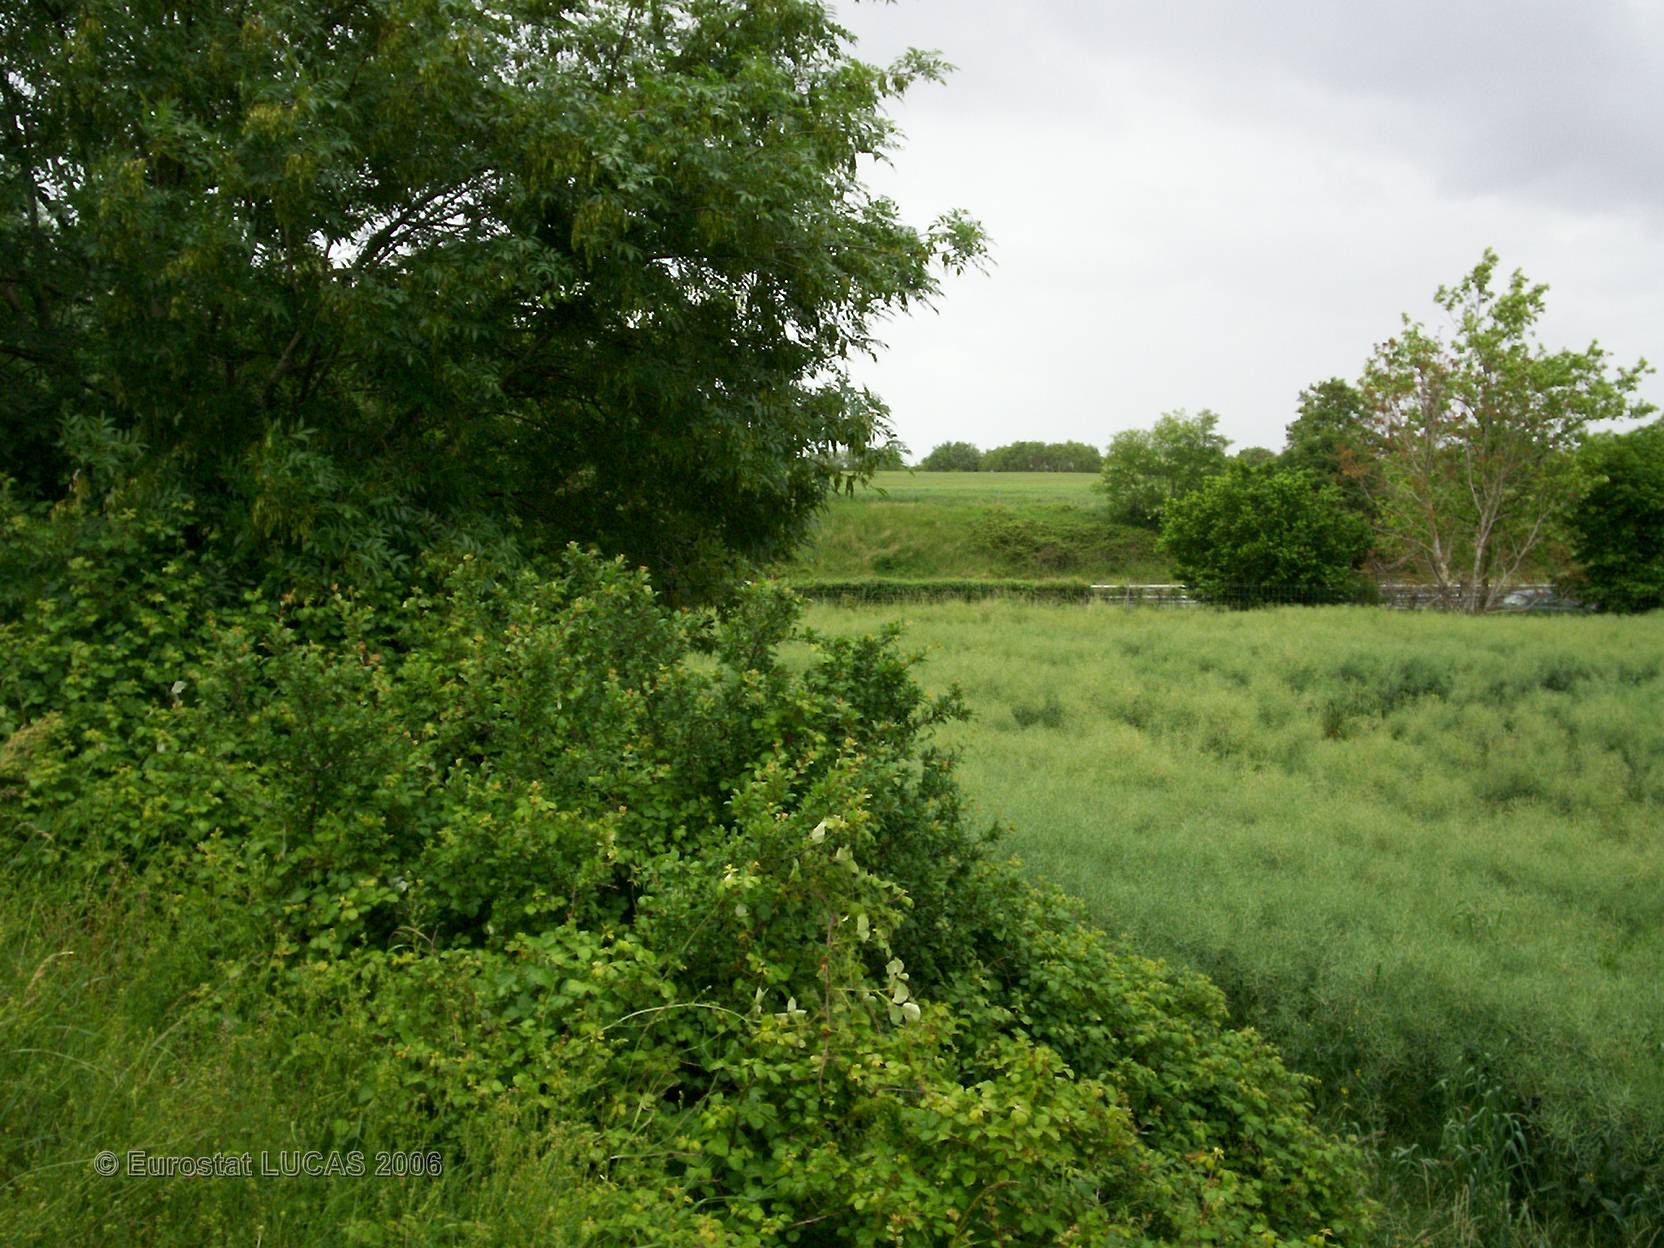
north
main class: Cropland
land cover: Rape and turnip rape
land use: Agriculture (excluding fallow land and kitchen gardens)
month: May
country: FR
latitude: 46.3679
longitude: -0.2273
